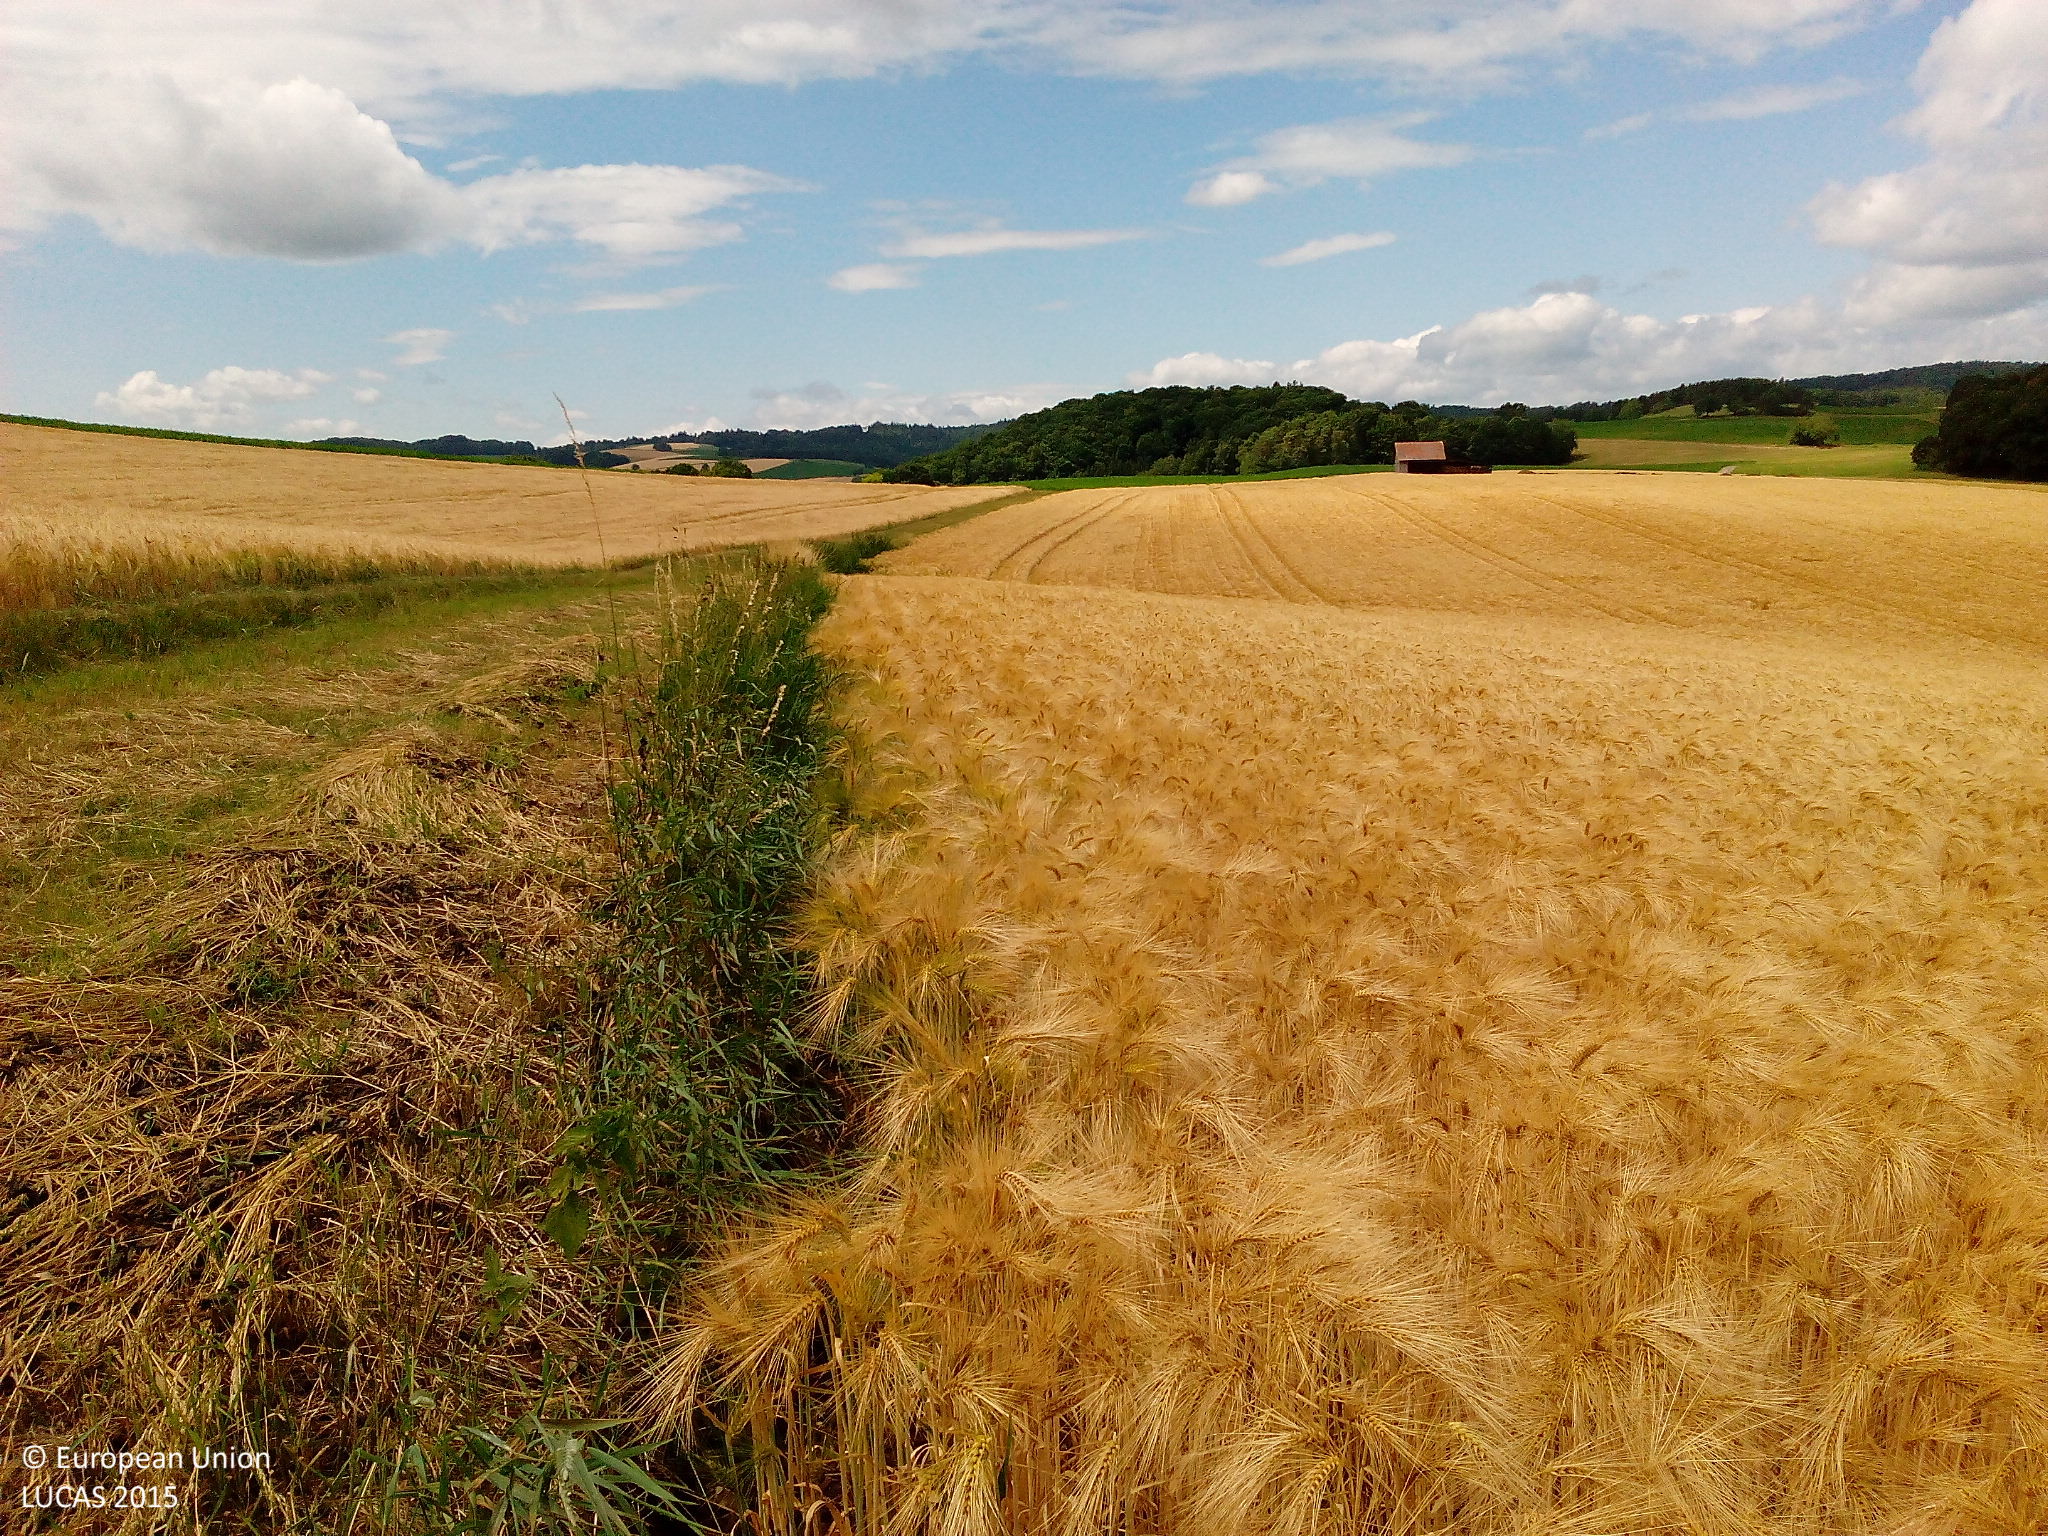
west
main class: Cropland
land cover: Barley
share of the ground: > 75 %
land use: Agriculture (excluding fallow land and kitchen gardens)
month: July
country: DE
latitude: 51.0651
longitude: 9.8431
